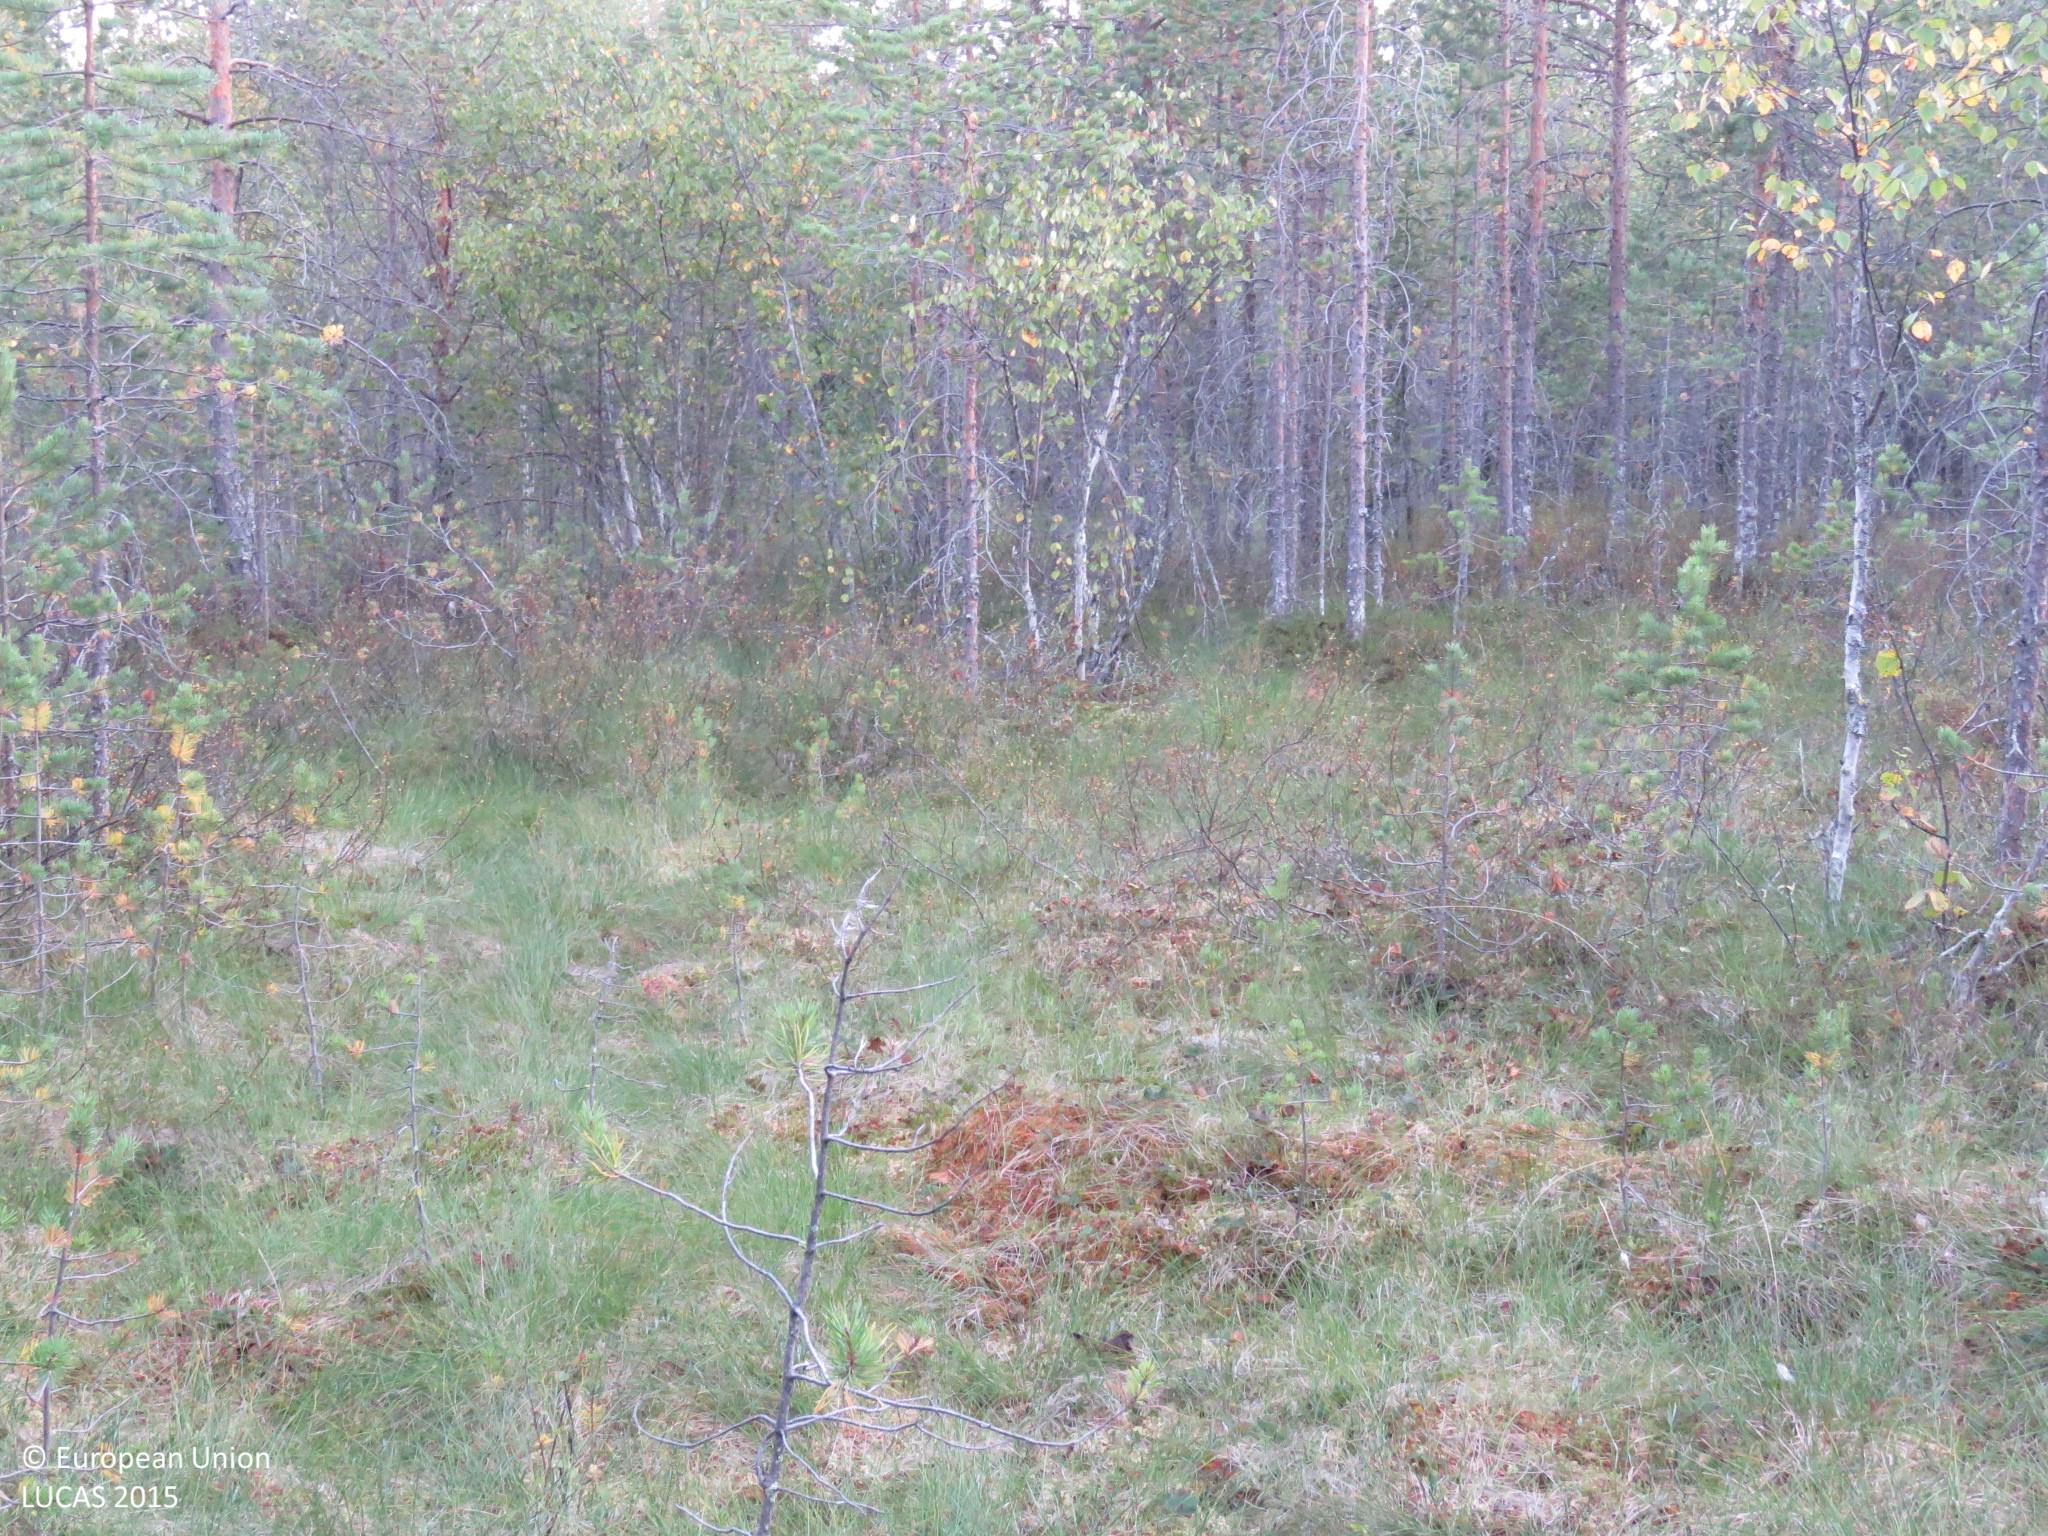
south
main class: Woodland
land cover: Pine dominated coniferous woodland
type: mire and swamp forests
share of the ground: 50 - 75 %
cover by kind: coniferous forest trees 50 %, herbaceous plants 20 %, broadleaved forest trees 15 %, shrubs 10 %, lichens and mosses 5 %
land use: Forestry
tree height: > 5 m
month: August
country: FI
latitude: 64.9970
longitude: 25.8901
